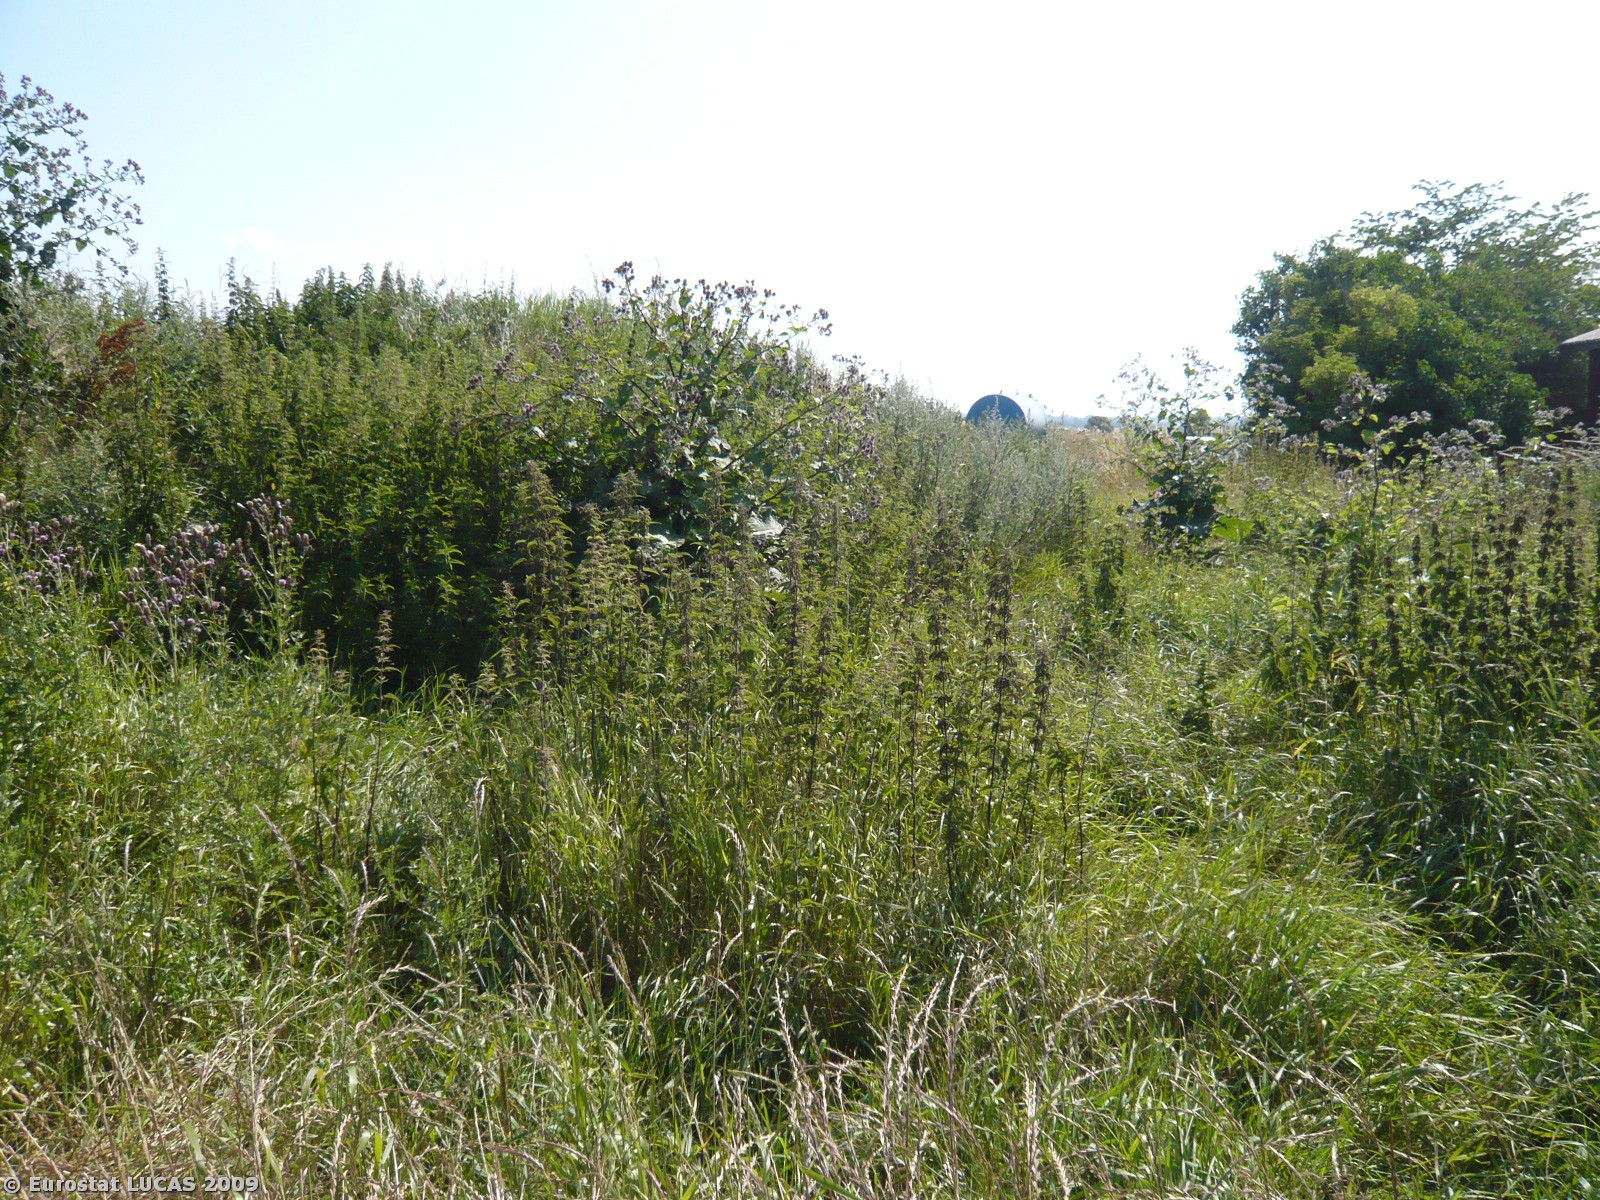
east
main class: Cropland
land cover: Rape and turnip rape
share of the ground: > 75 %
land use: Agriculture (excluding fallow land and kitchen gardens)
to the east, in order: Rape and turnip rape; Common wheat; Tracks; Grass margins; Potatoes; Barley; Common wheat; Fences; Single bushes/trees; Common wheat
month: July
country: DK
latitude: 55.8200
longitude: 11.4510
